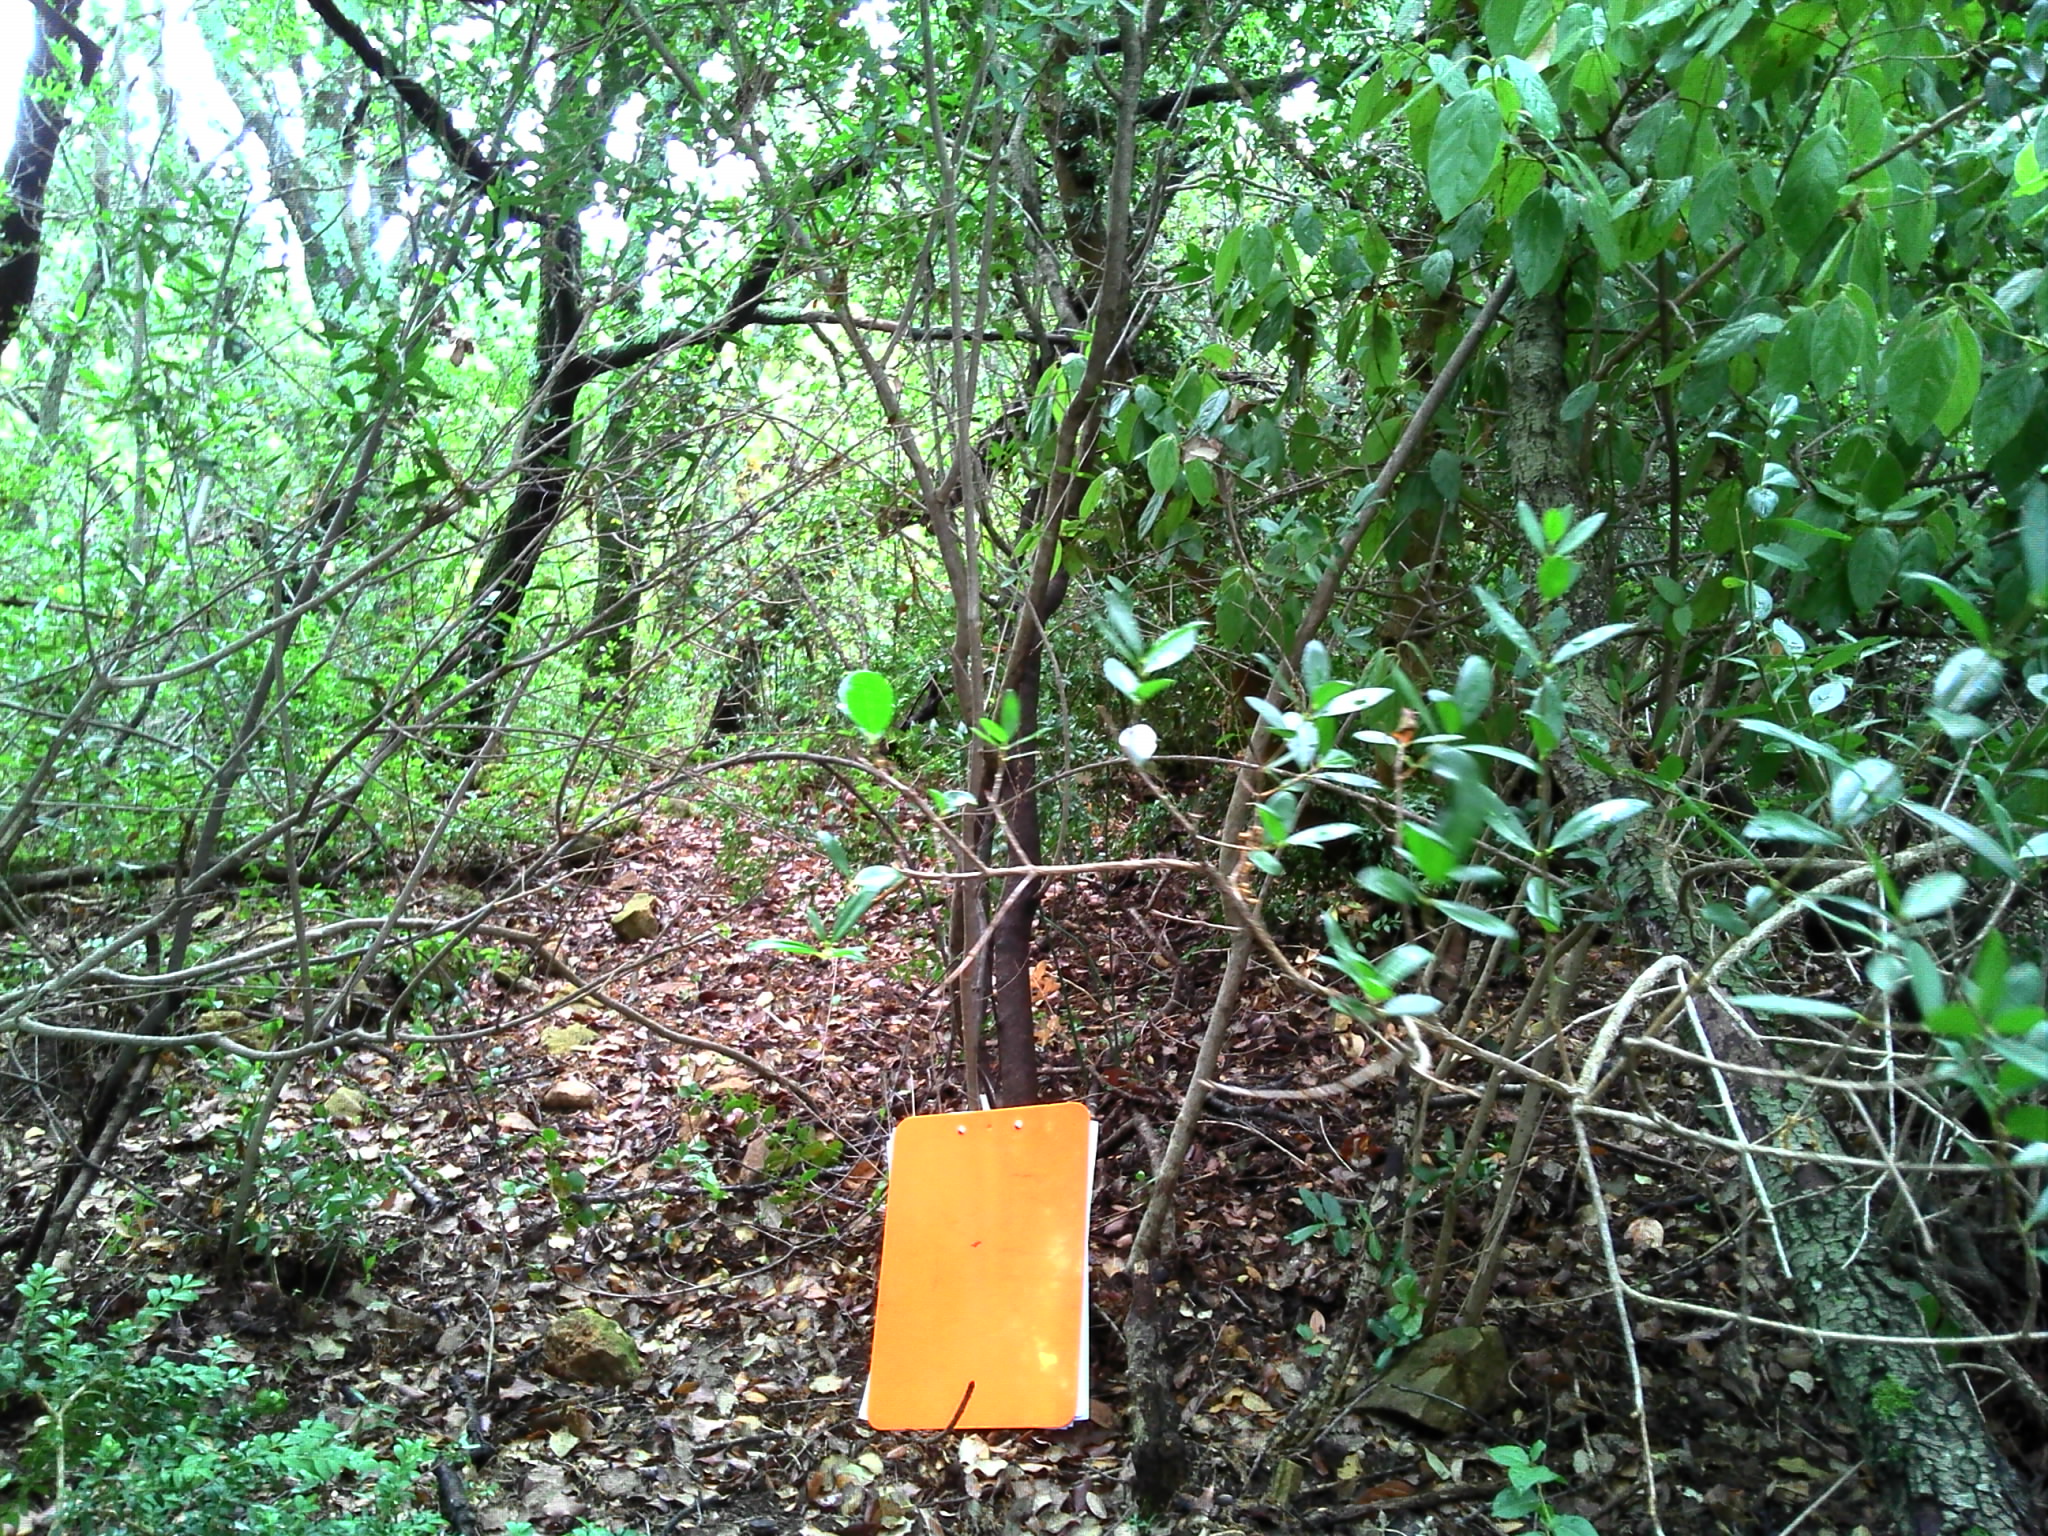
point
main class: Woodland
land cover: Broadleaved woodland
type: broadleaved evergreen forest
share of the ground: > 75 %
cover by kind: broadleaved forest trees 60 %, consolidated bare surface 20 %, shrubs 10 %, herbaceous plants 10 %
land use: Semi-natural and natural areas not in use
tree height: > 5 m
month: August
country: FR
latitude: 44.1220
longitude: 4.6470
